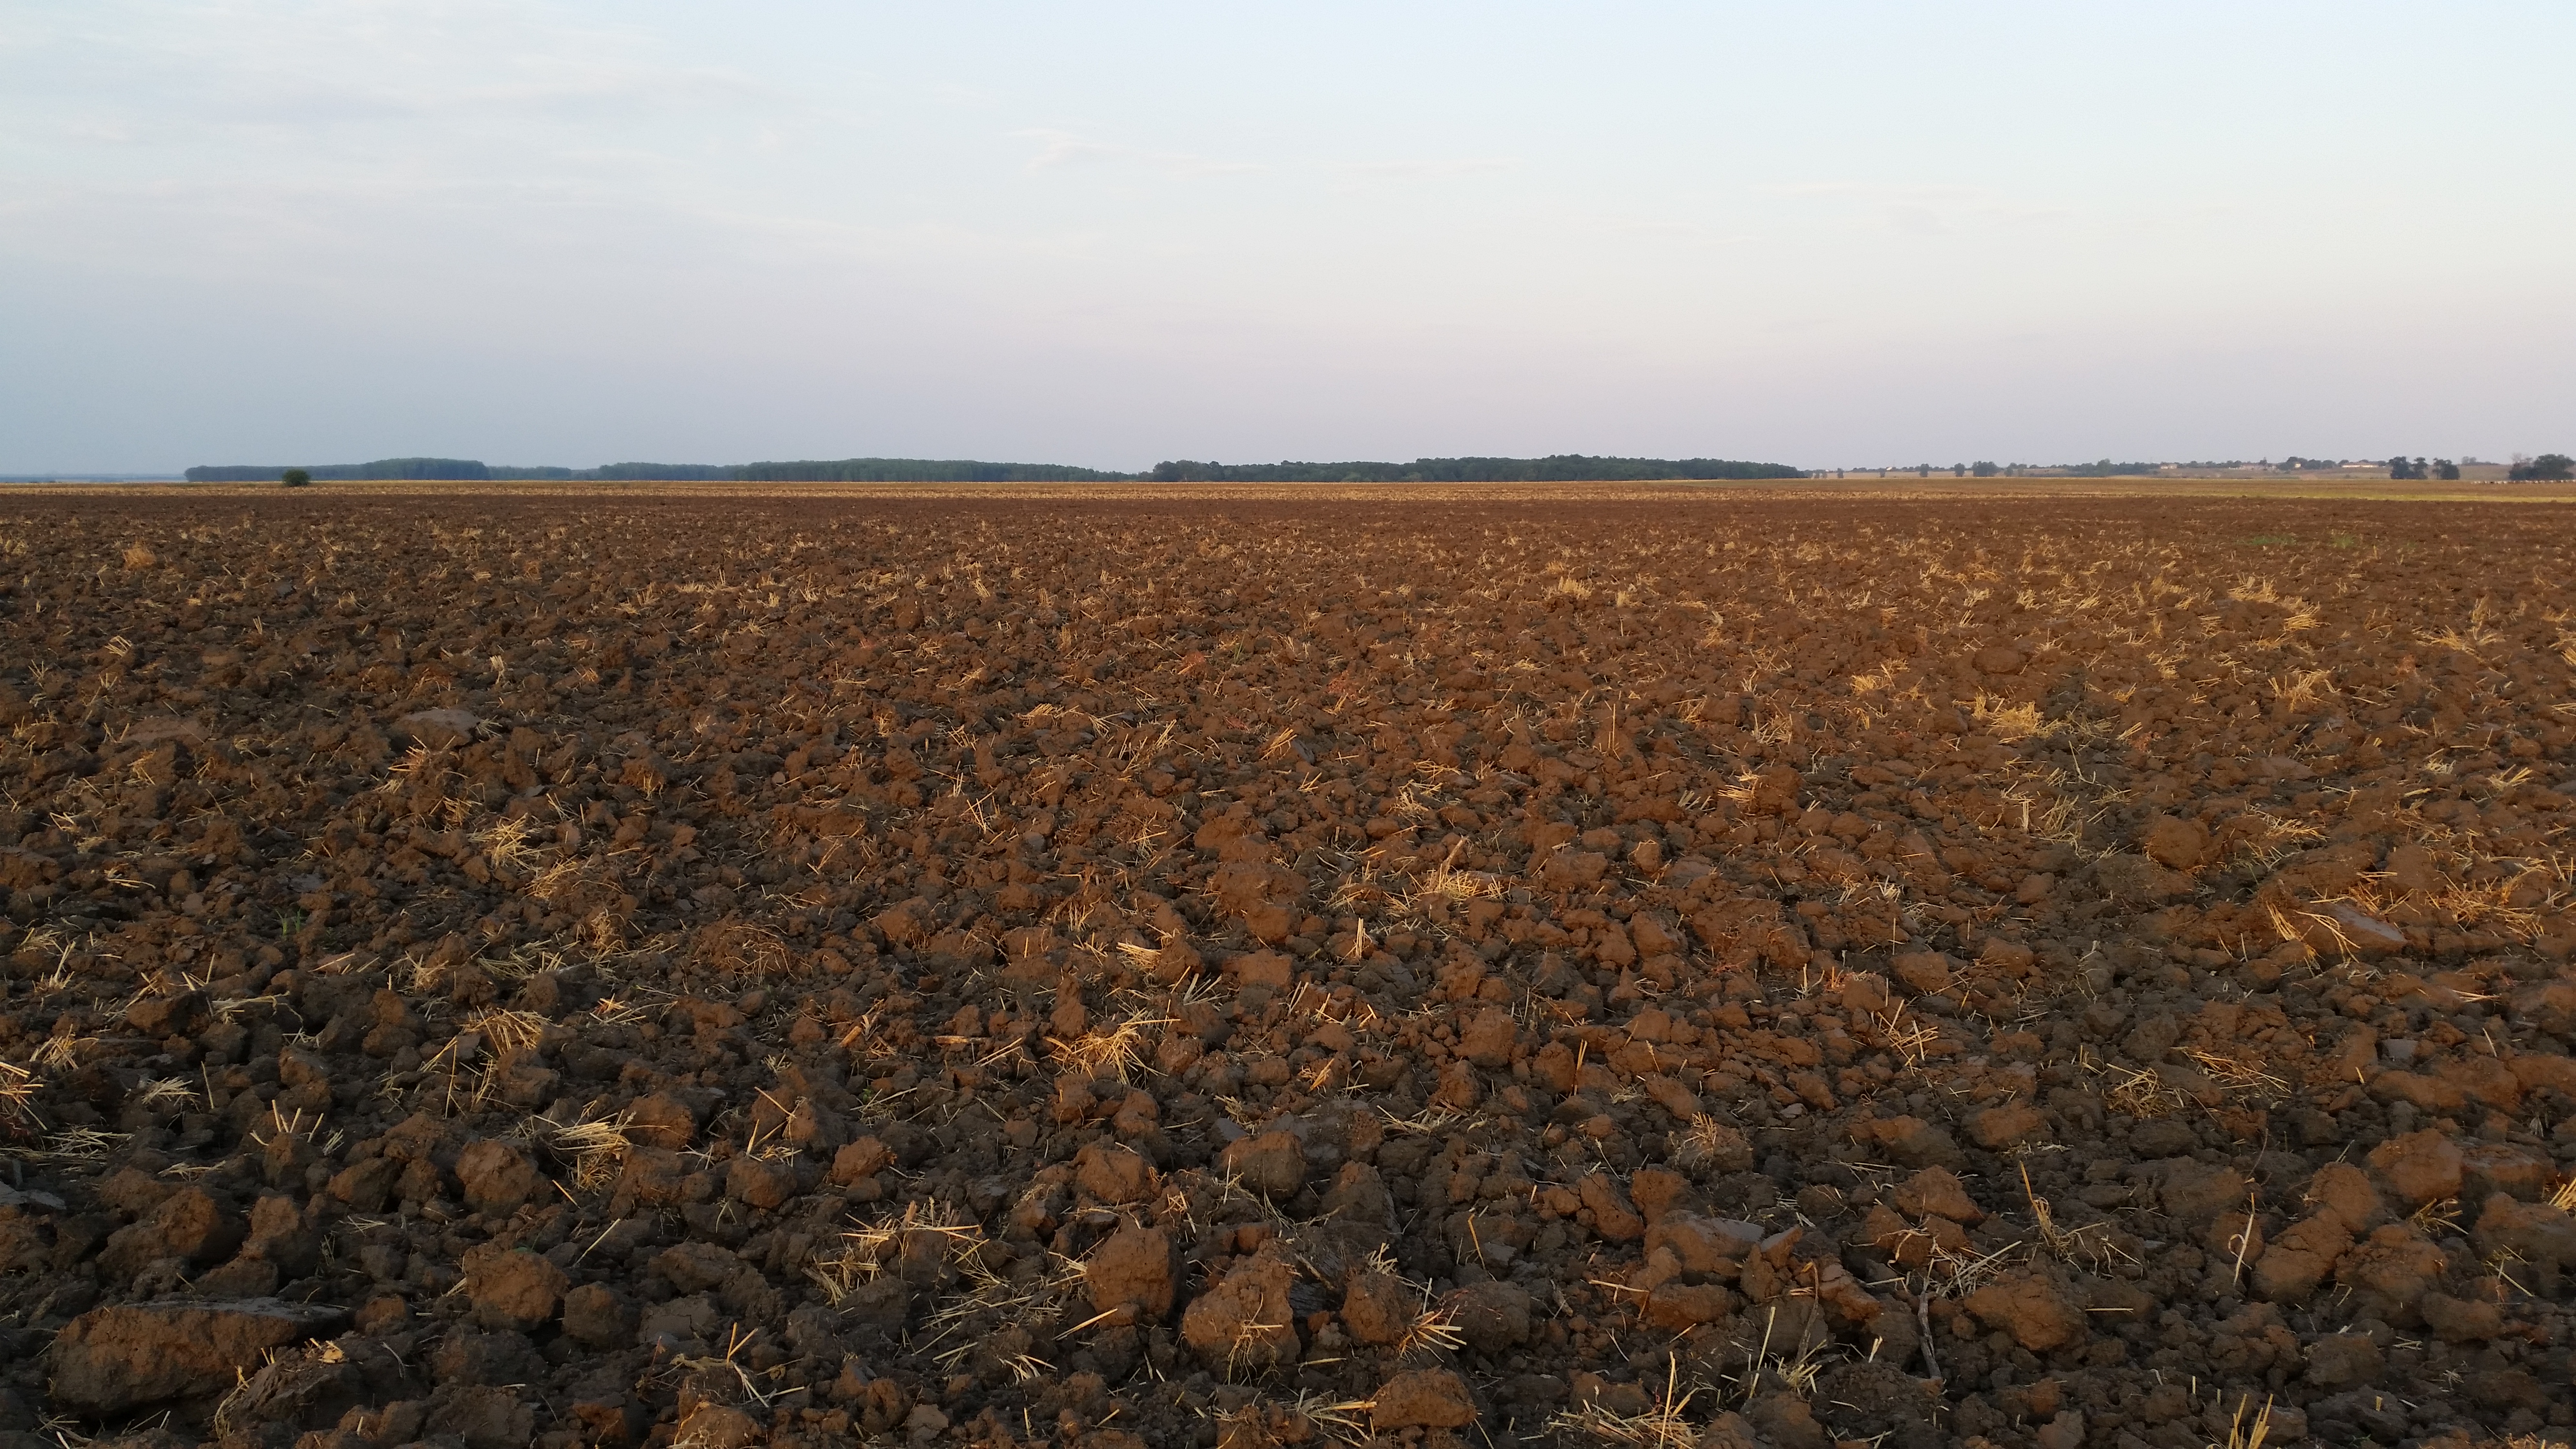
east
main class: Cropland
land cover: Common wheat
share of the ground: < 10 %
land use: Agriculture (excluding fallow land and kitchen gardens)
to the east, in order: Common wheat
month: August
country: RO
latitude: 44.0364
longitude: 23.5900
